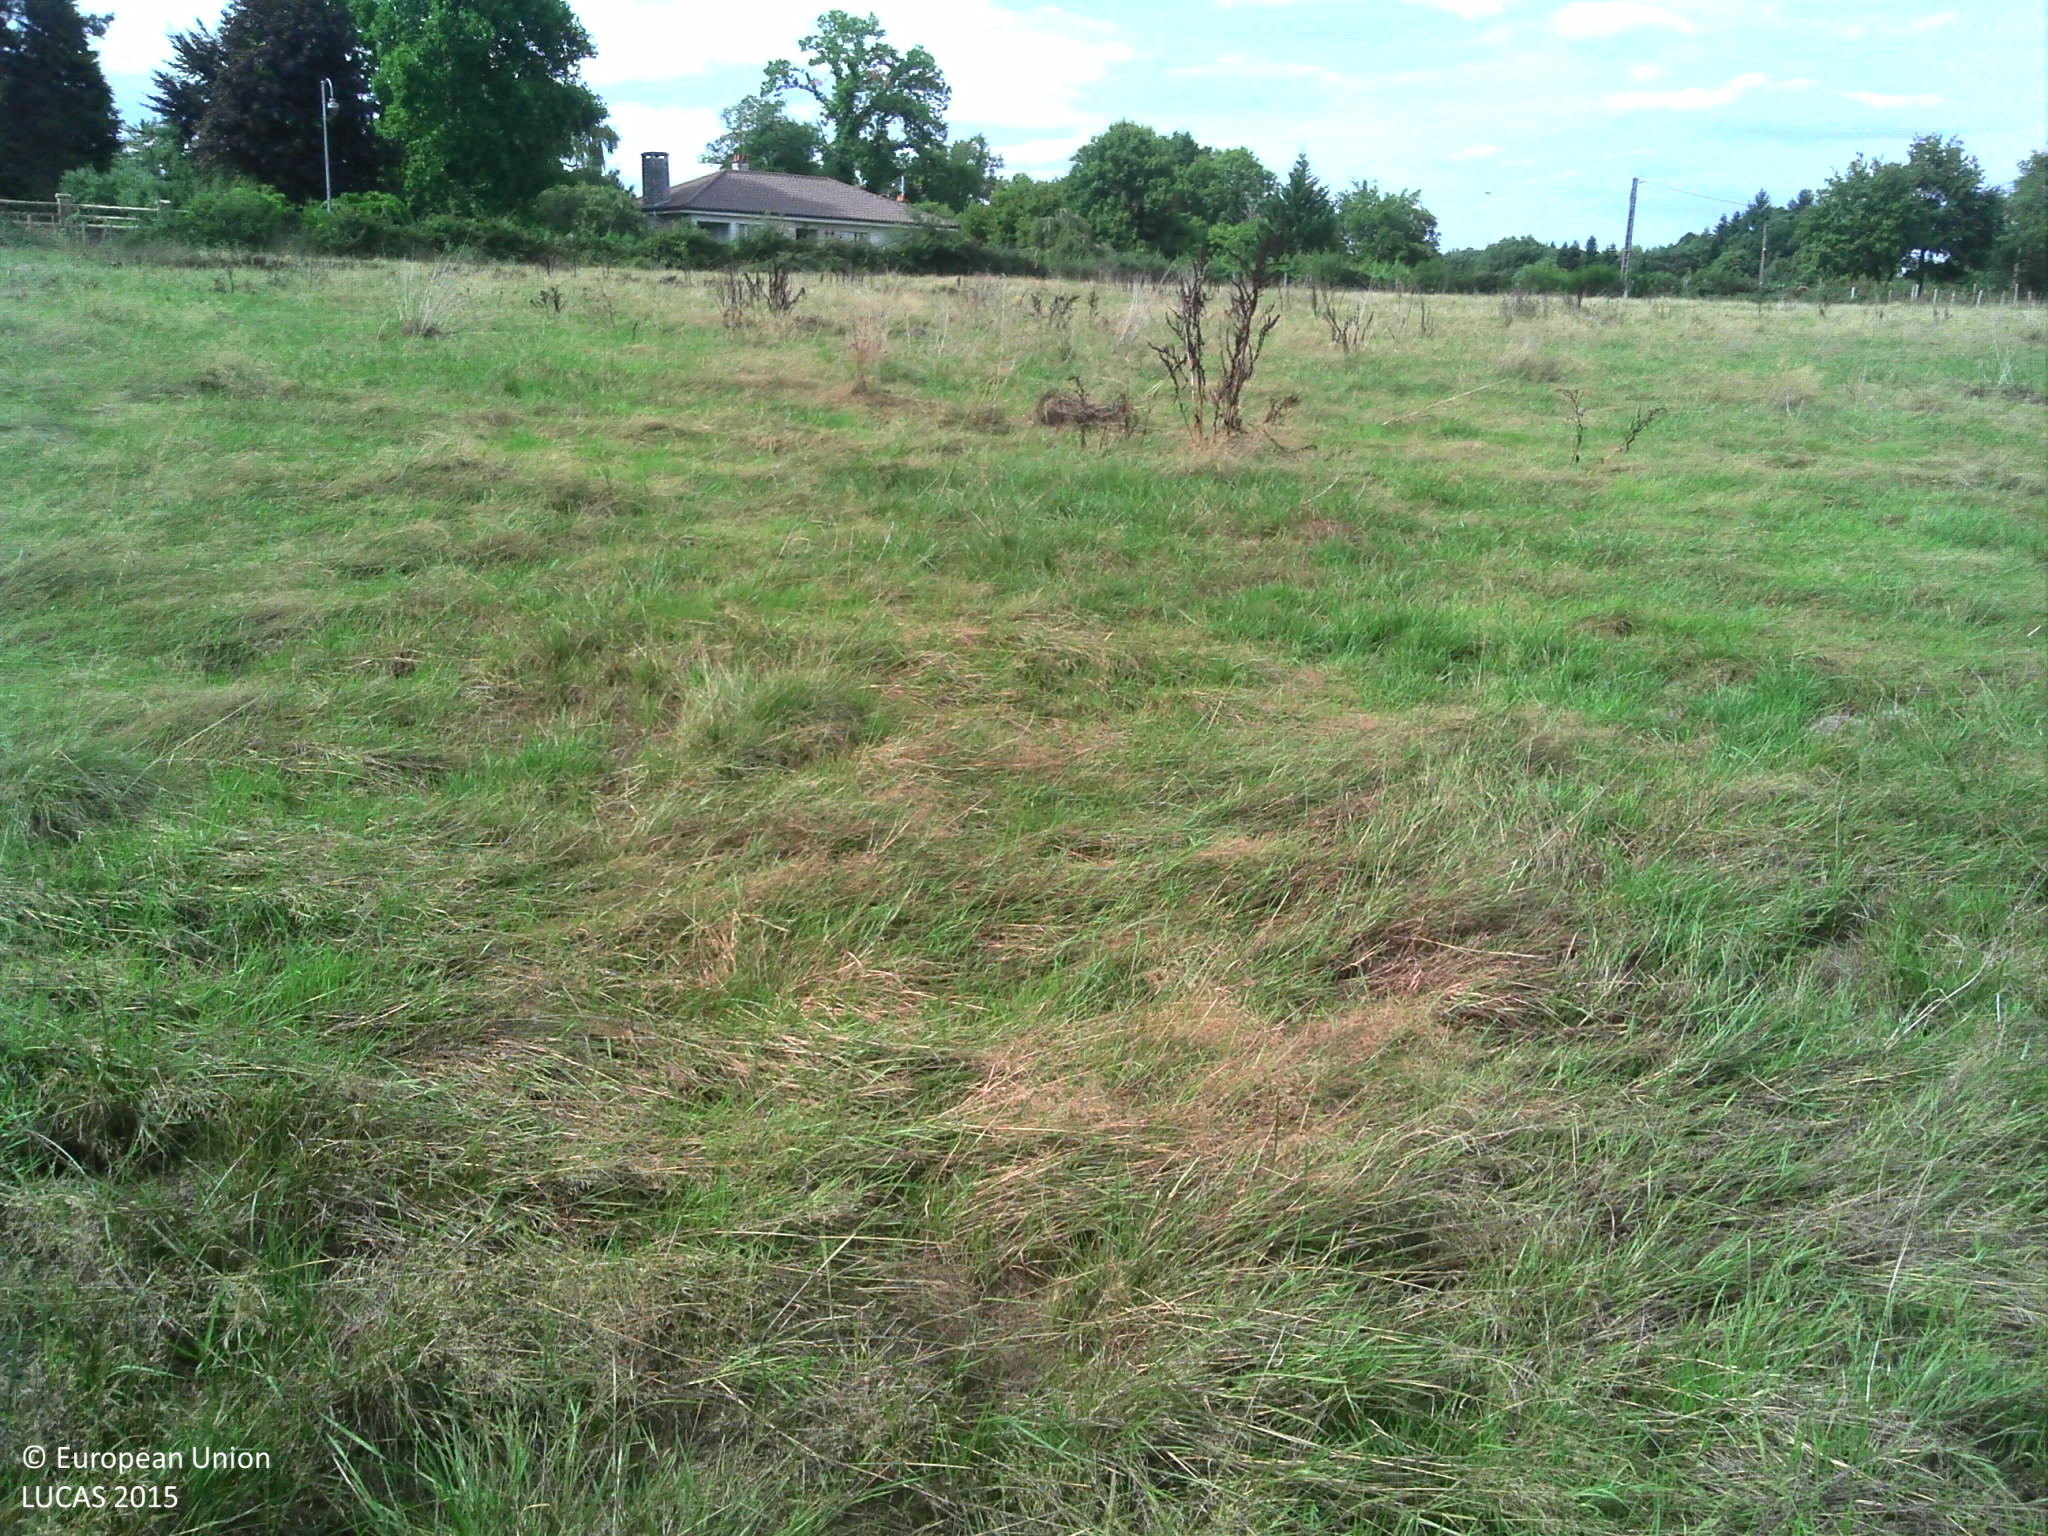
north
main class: Grassland
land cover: Grassland without tree/shrub cover
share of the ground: > 75 %
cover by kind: herbaceous plants 95 %, shrubs 5 %
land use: Agriculture (excluding fallow land and kitchen gardens)
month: August
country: FR
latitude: 46.1708
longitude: 1.2204
